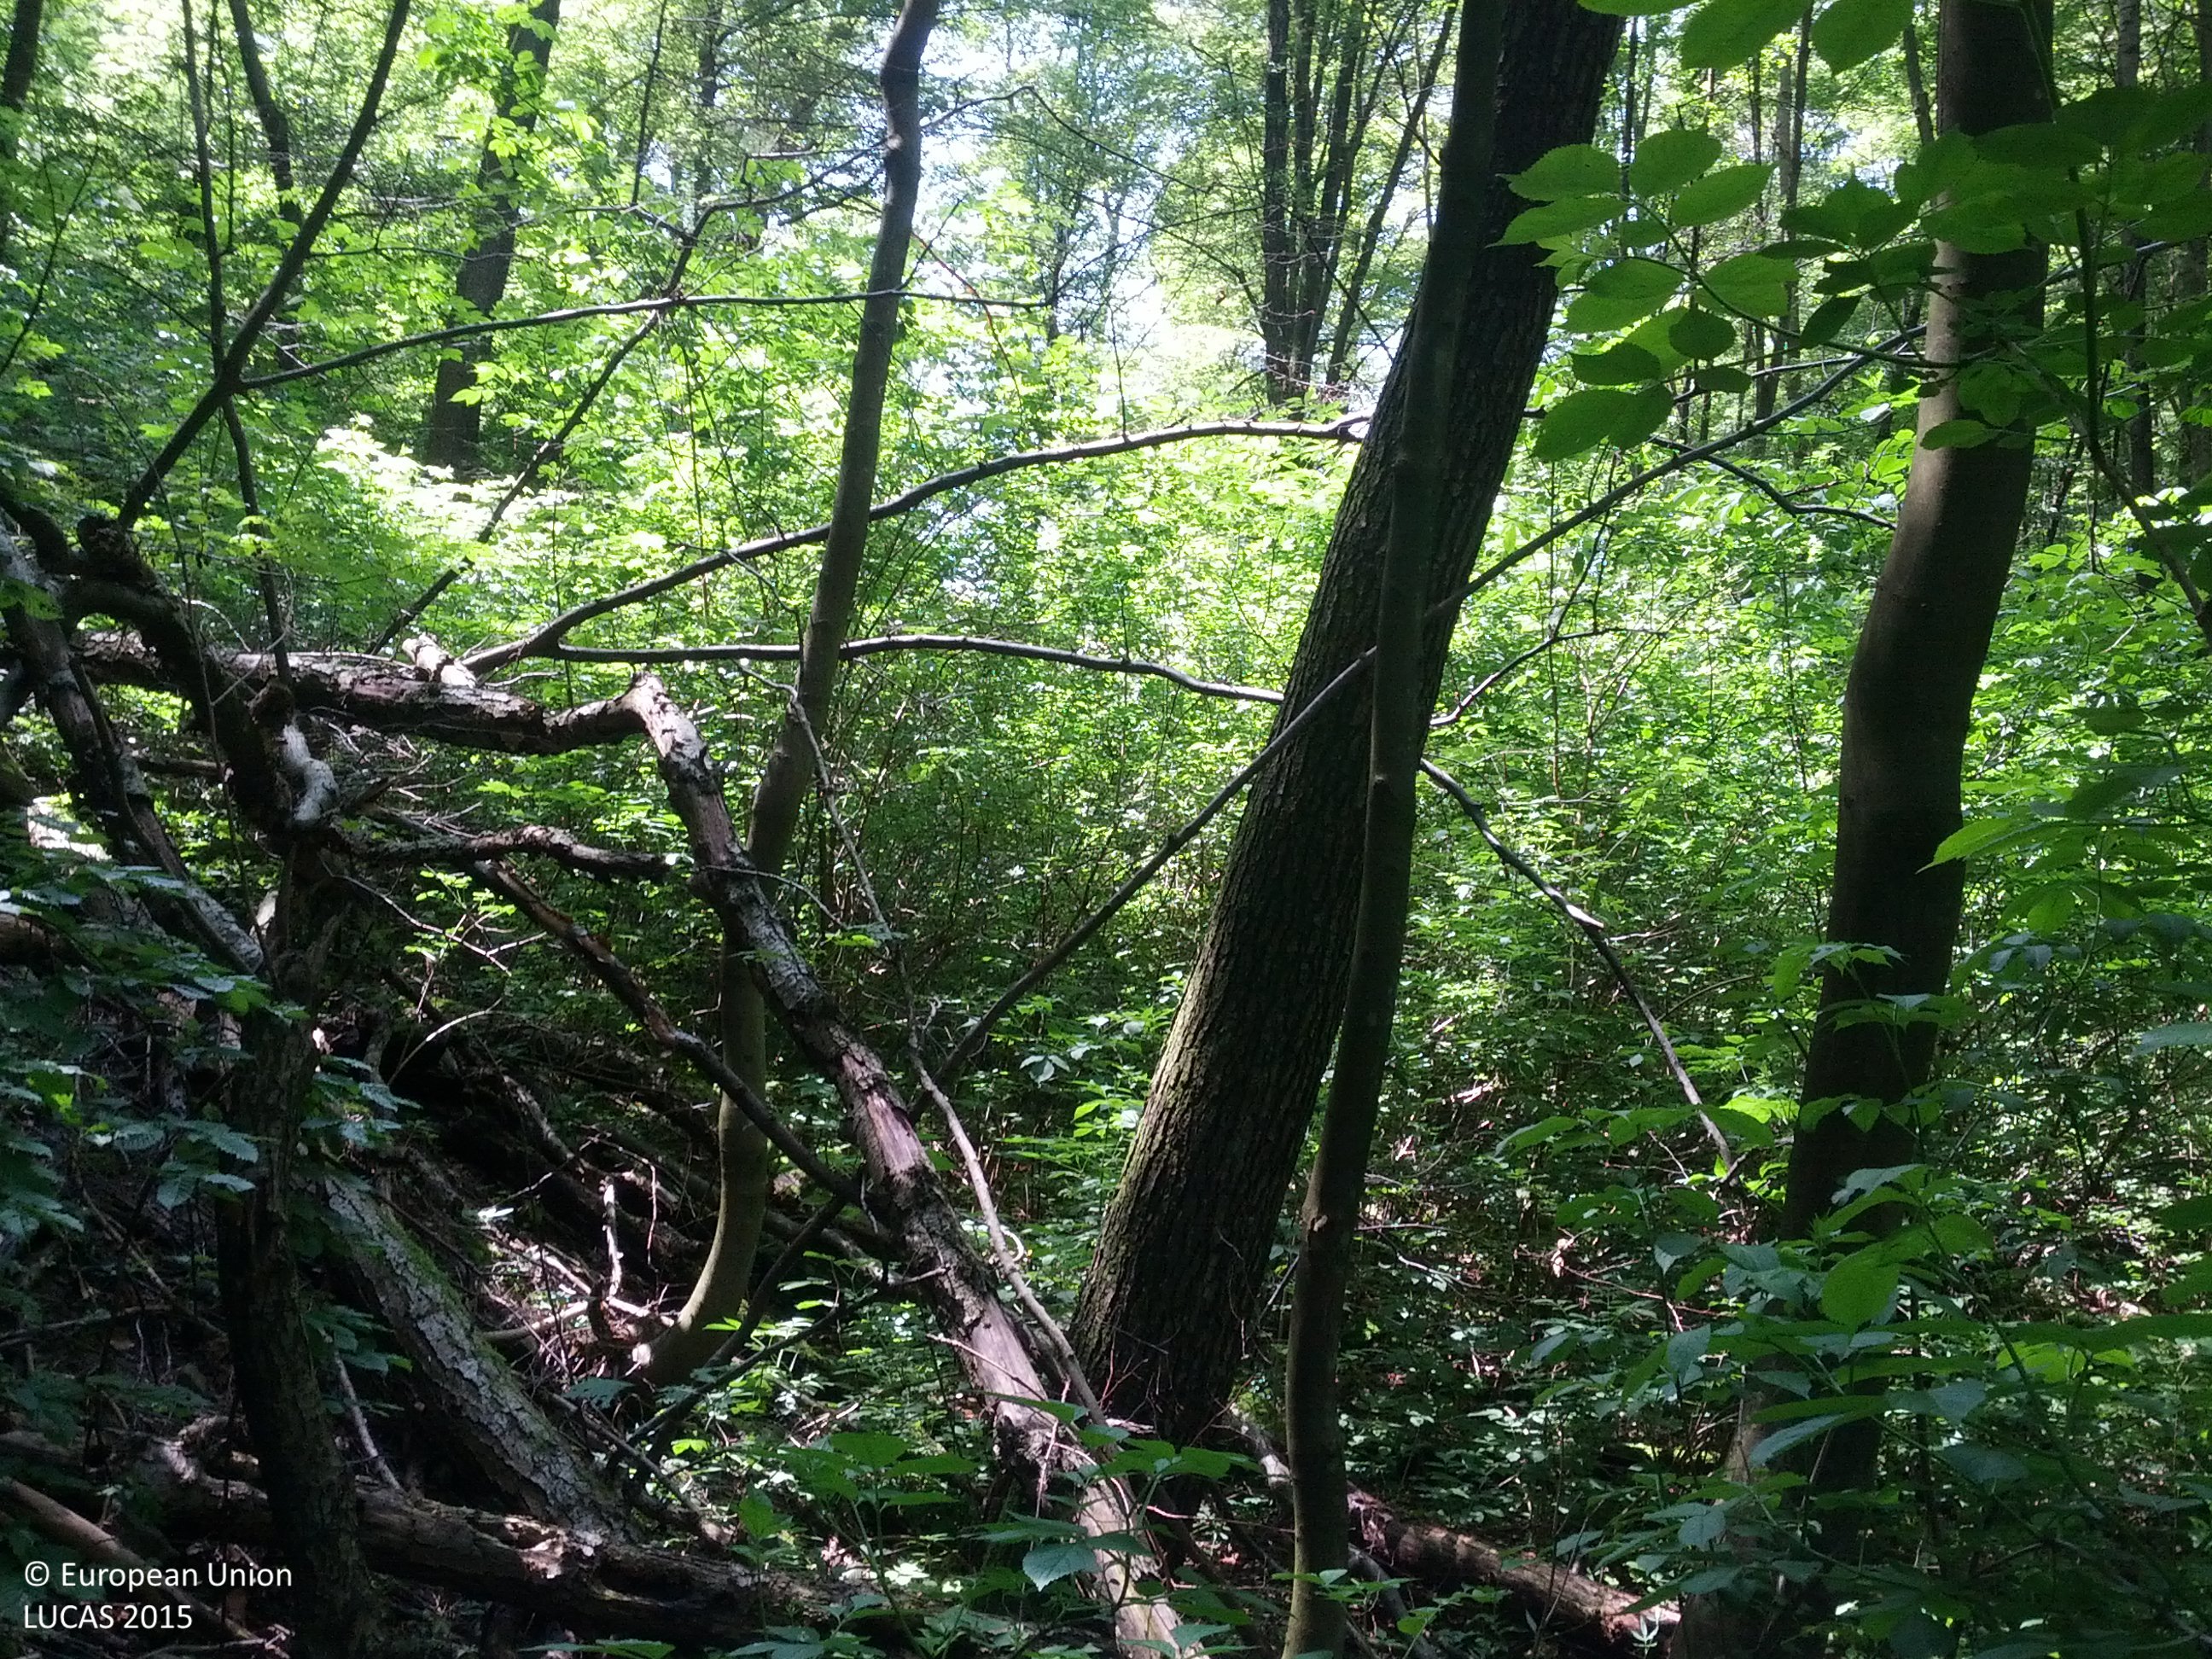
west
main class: Woodland
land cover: Broadleaved woodland
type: beech forest
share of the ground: > 75 %
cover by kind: broadleaved forest trees 80 %, shrubs 10 %, herbaceous plants 10 %
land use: Forestry
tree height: > 5 m
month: May
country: AT
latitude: 48.2334
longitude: 16.1300
